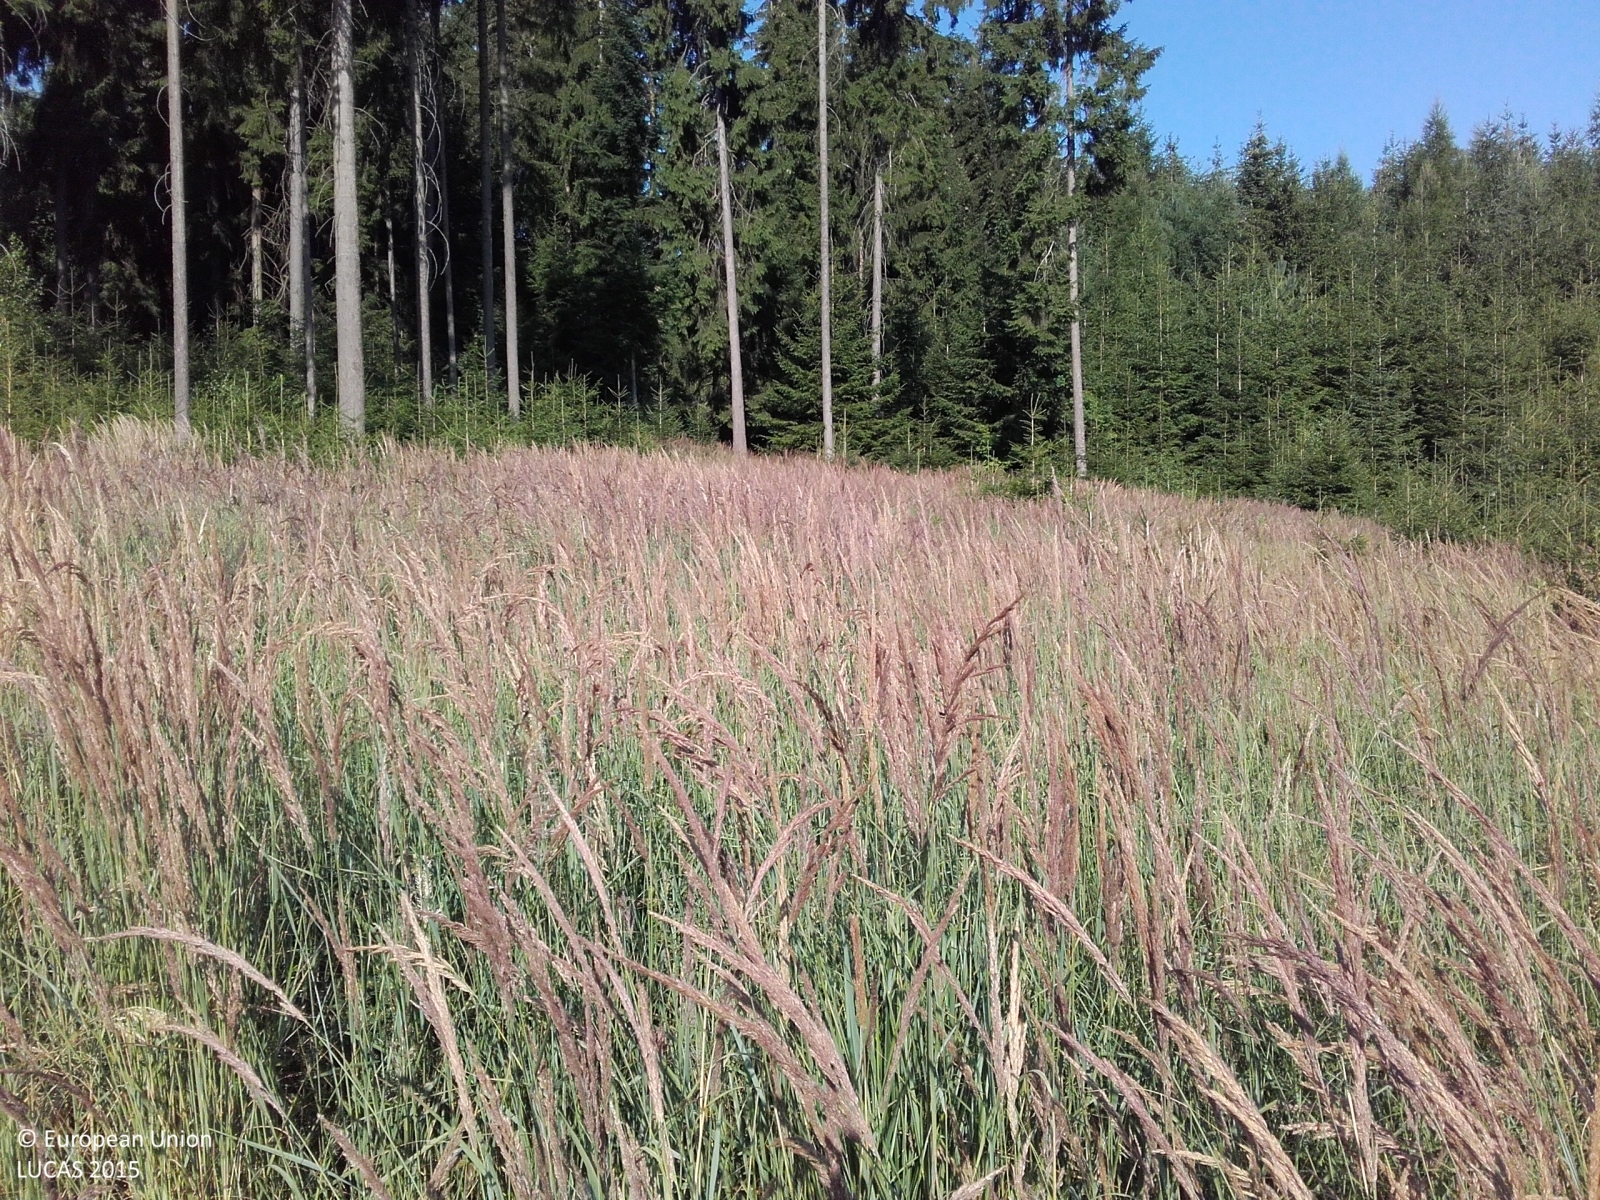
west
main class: Grassland
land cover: Spontaneously vegetated surfaces
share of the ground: > 75 %
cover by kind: herbaceous plants 100 %
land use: Forestry
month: July
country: CZ
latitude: 49.9353
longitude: 16.3461
